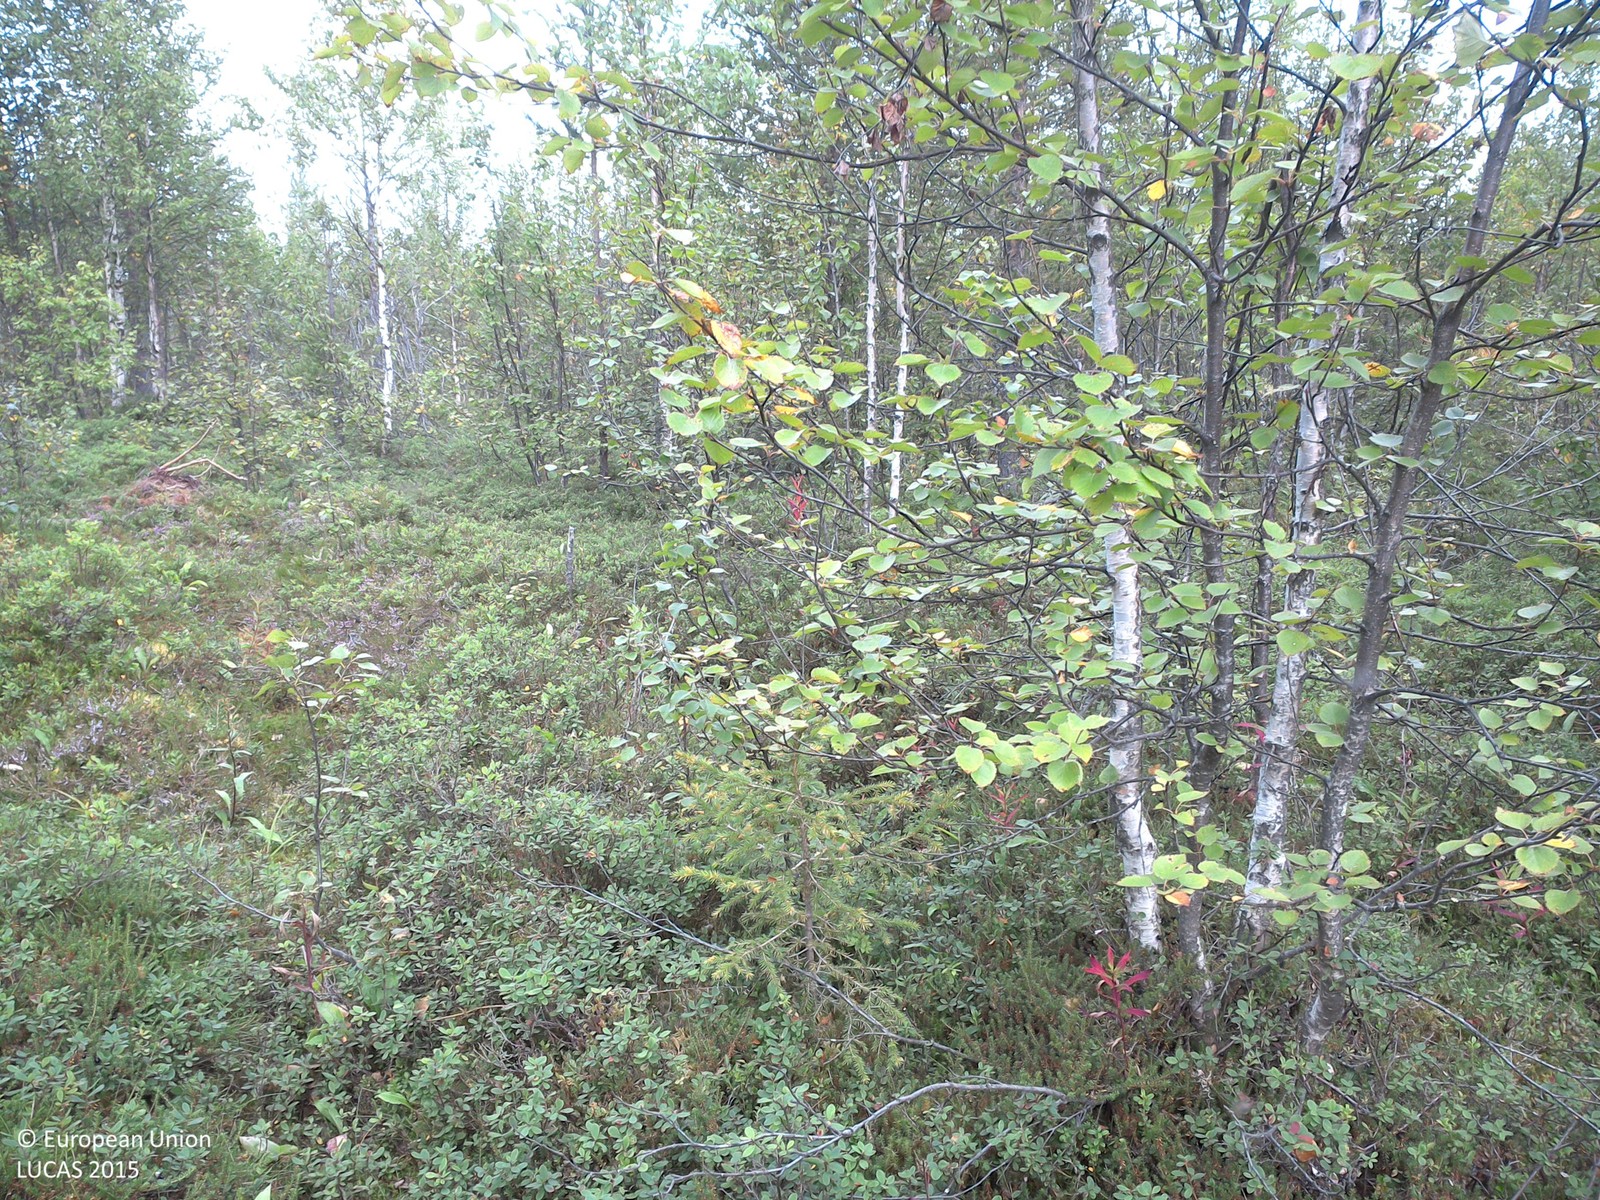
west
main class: Woodland
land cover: Other mixed woodland
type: boreal forest
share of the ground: 25 - 50 %
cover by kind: shrubs 65 %, broadleaved forest trees 20 %, coniferous forest trees 10 %, lichens and mosses 5 %
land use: Forestry
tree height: > 5 m
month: August
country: SE
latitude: 67.3410
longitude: 22.1689
